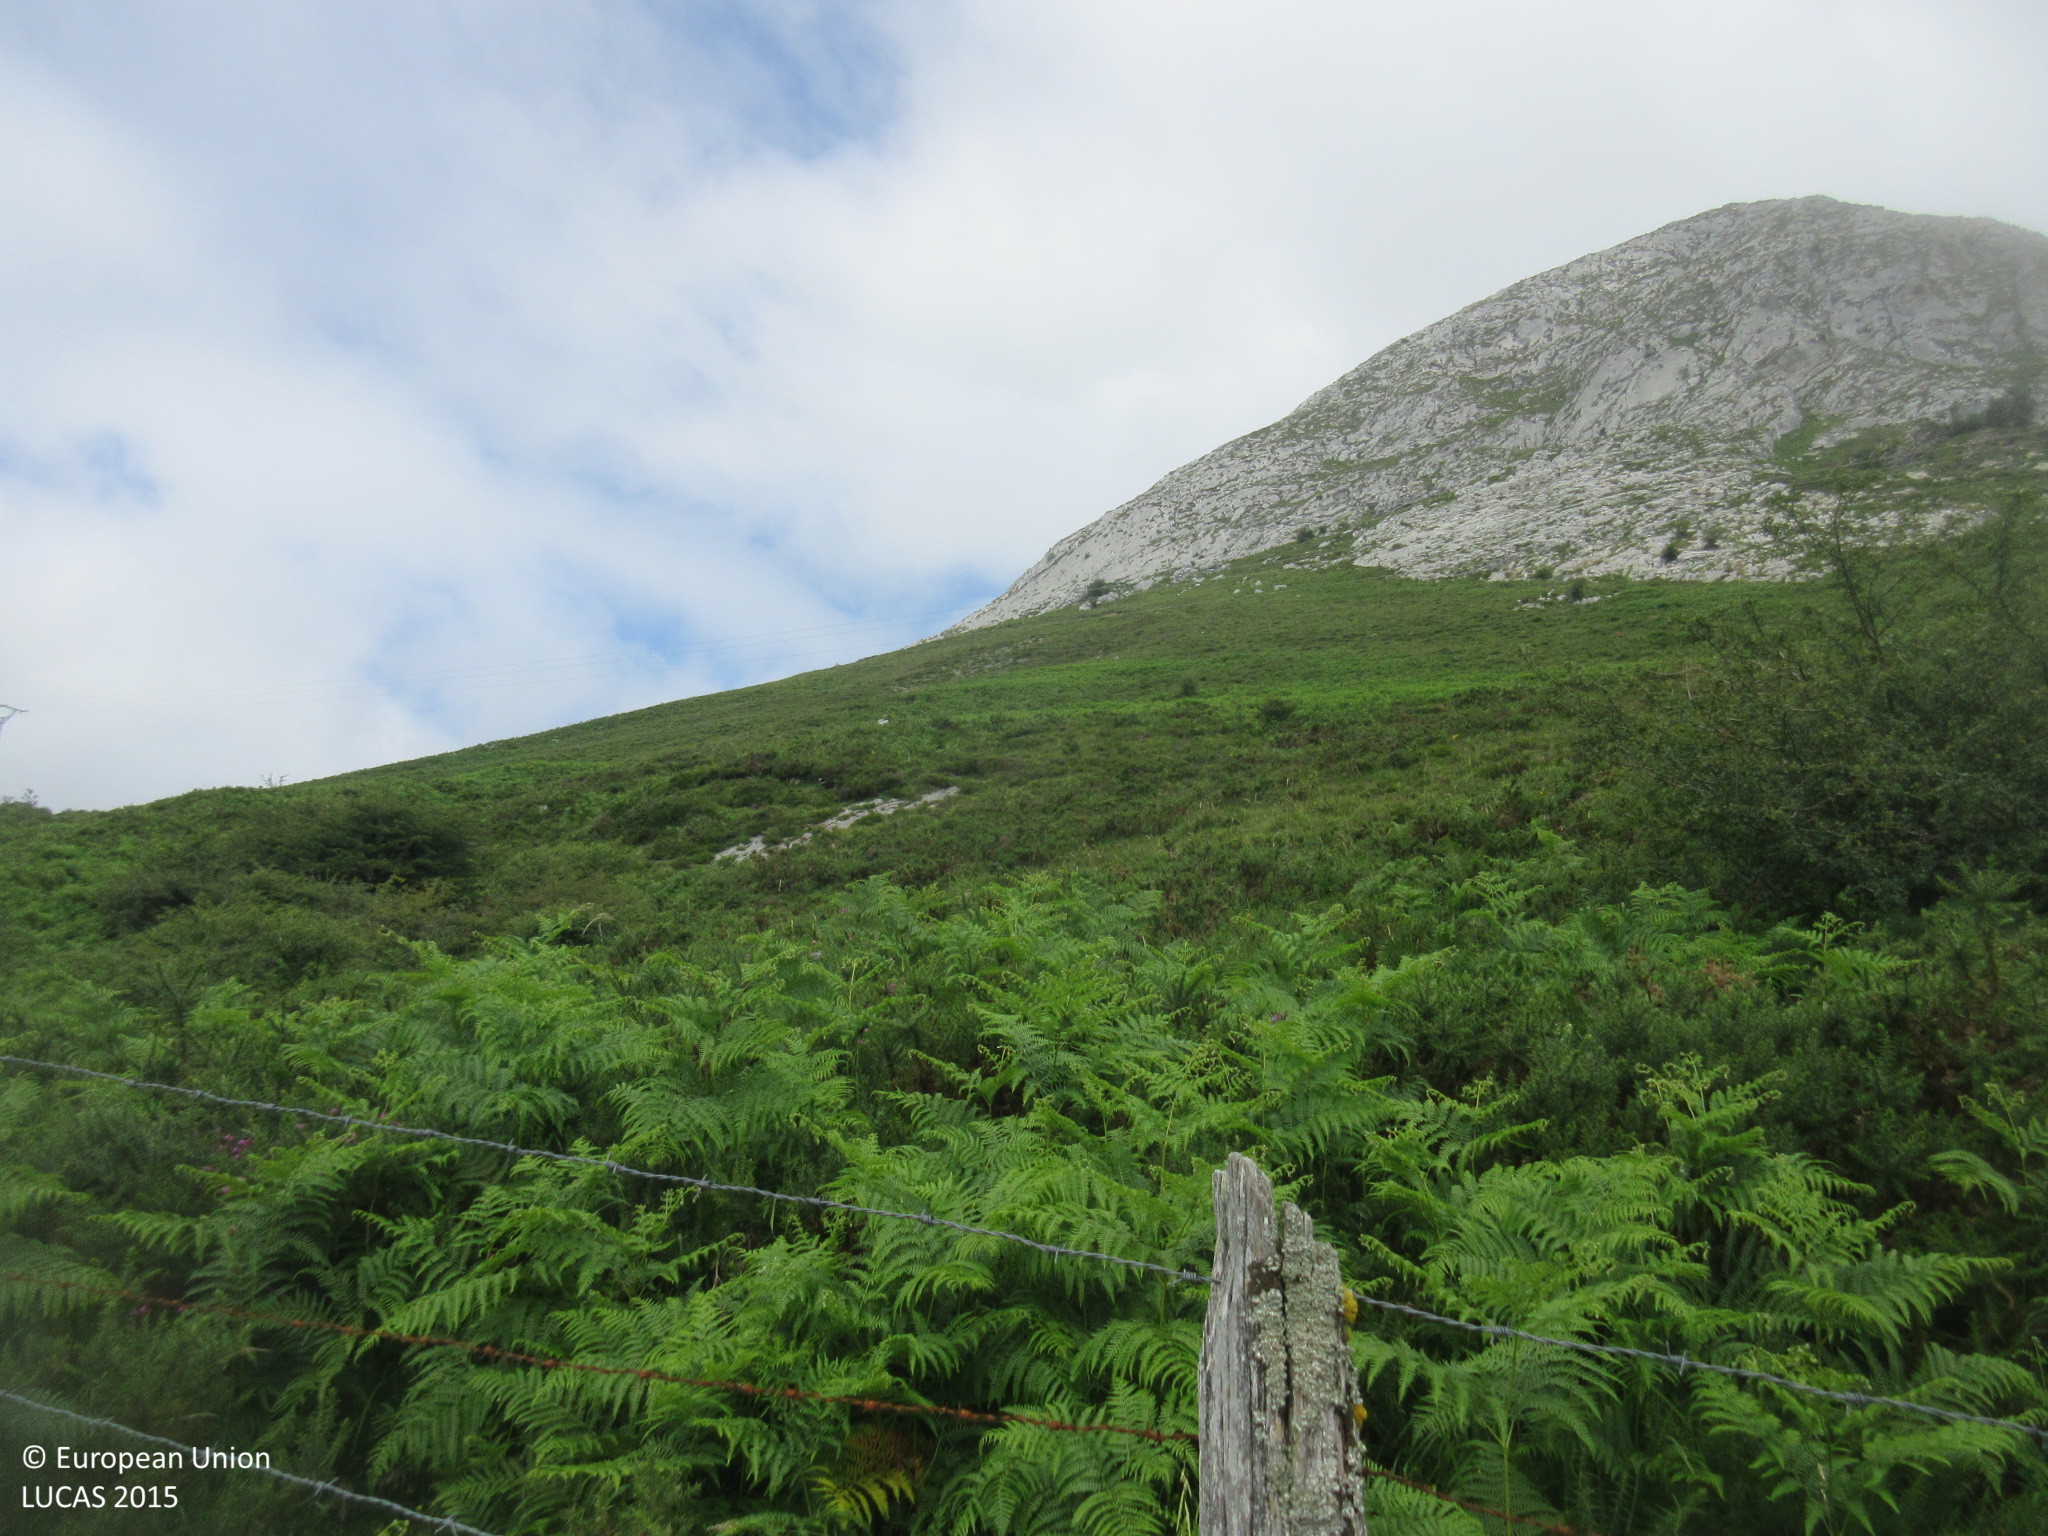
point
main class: Shrubland
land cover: Shrubland without tree cover
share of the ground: > 75 %
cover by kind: shrubs 100 %
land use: Semi-natural and natural areas not in use
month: July
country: ES
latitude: 43.2199
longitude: -3.5476
